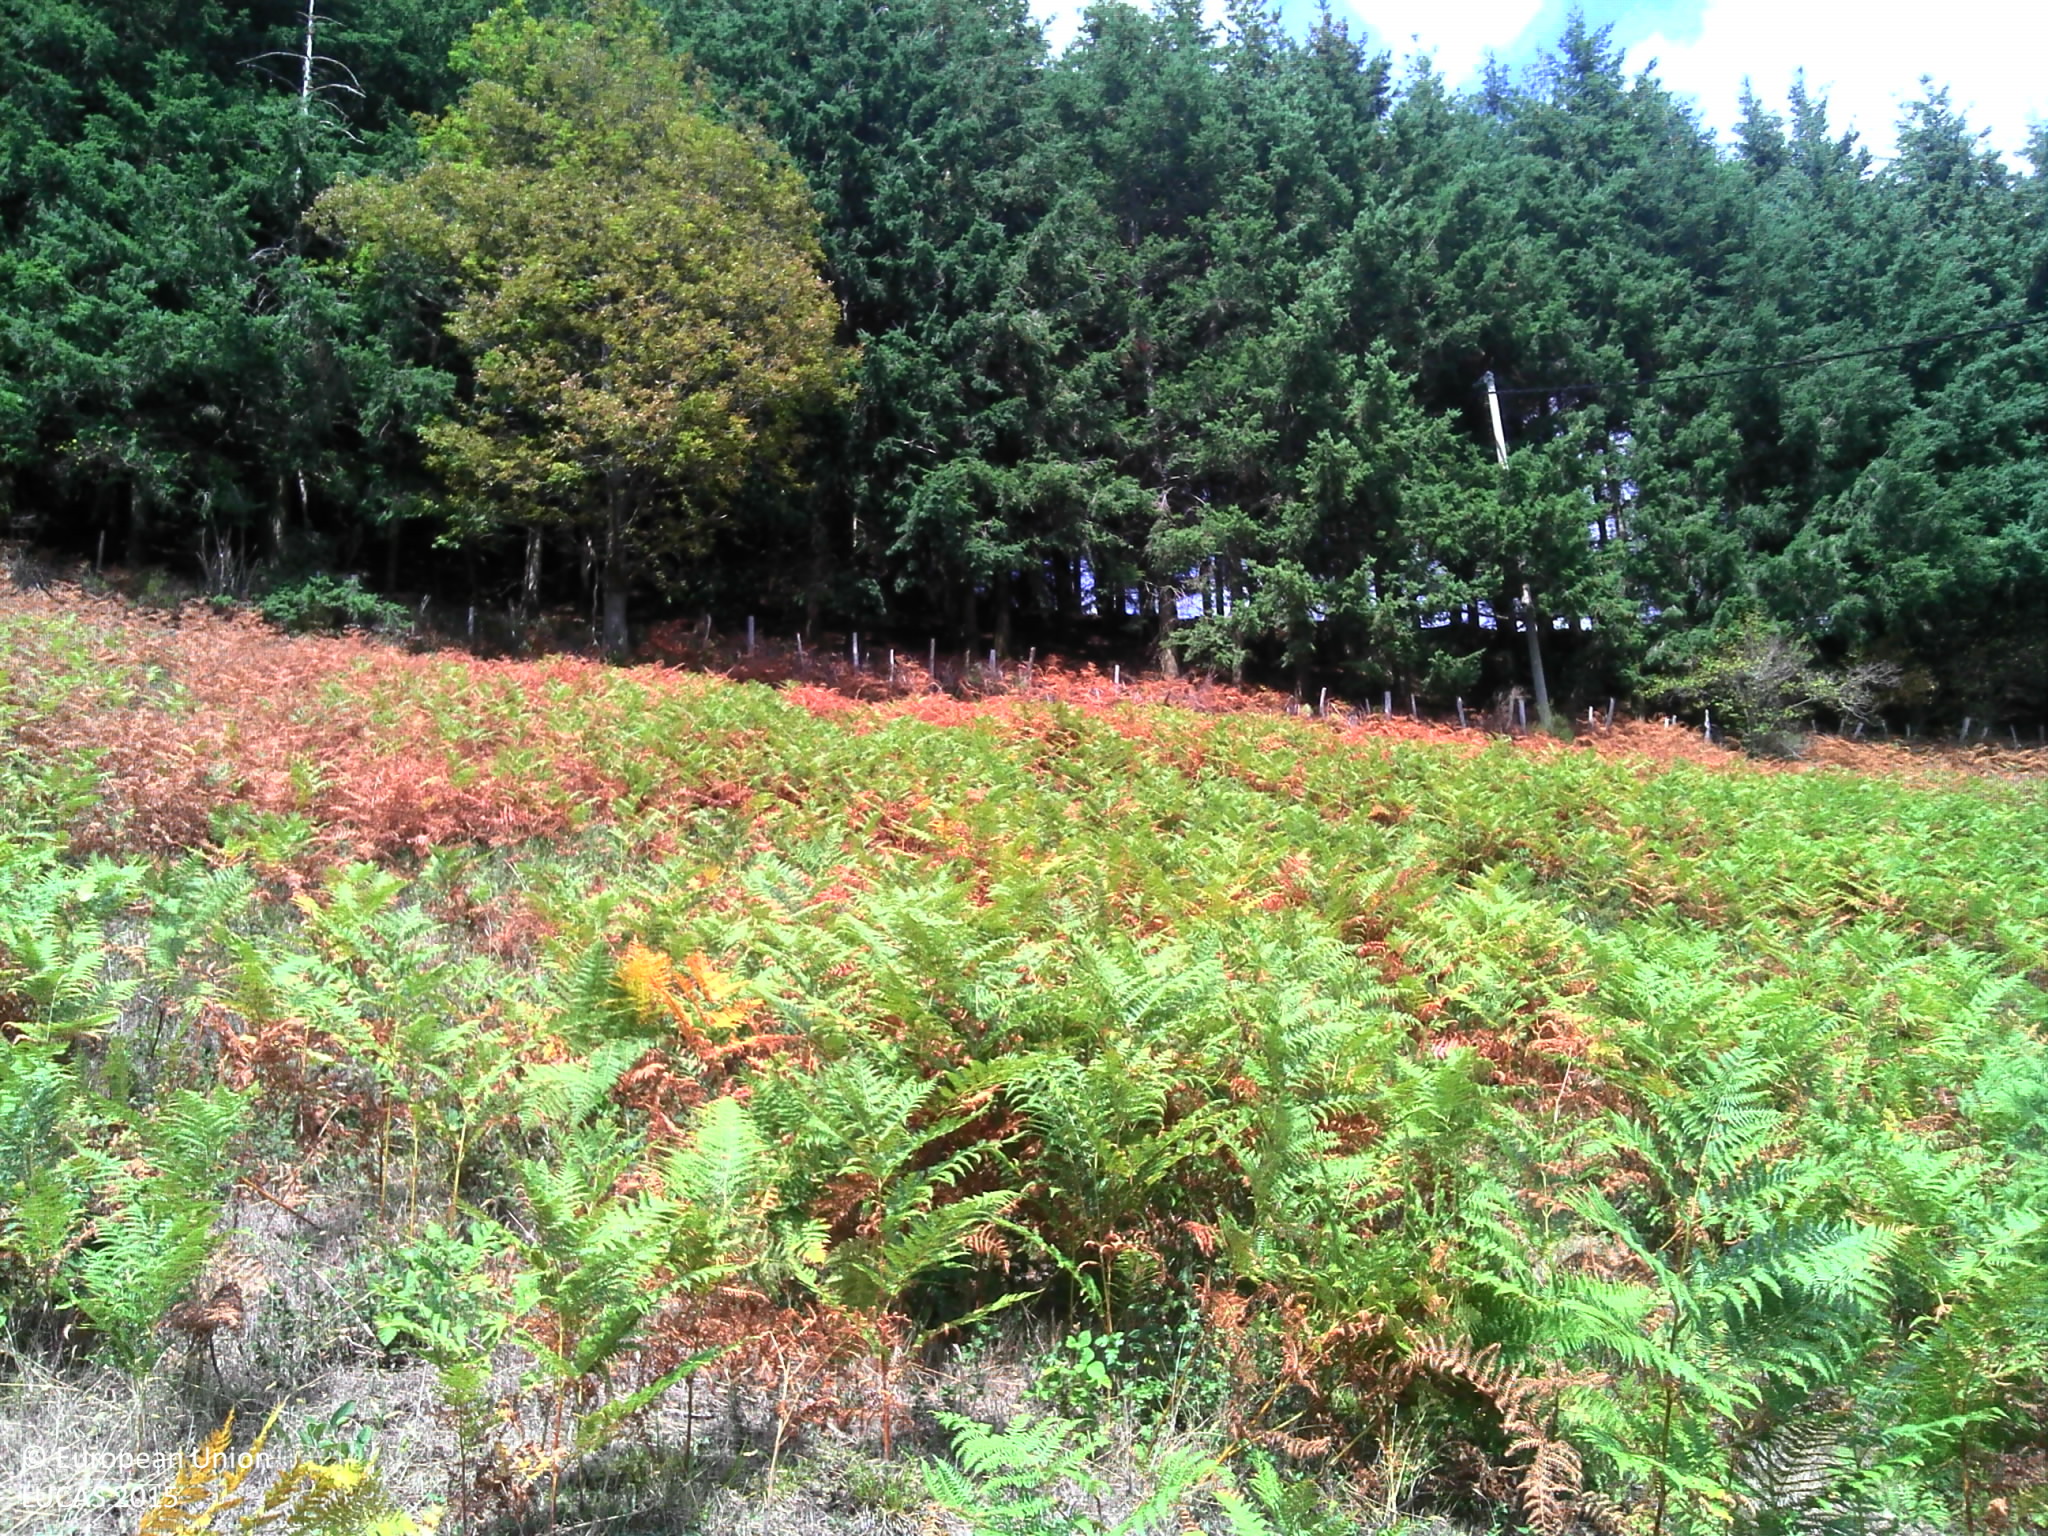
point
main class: Grassland
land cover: Spontaneously vegetated surfaces
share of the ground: > 75 %
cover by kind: herbaceous plants 100 %
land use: Agriculture (excluding fallow land and kitchen gardens)
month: August
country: FR
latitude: 46.1030
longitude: 4.5302
